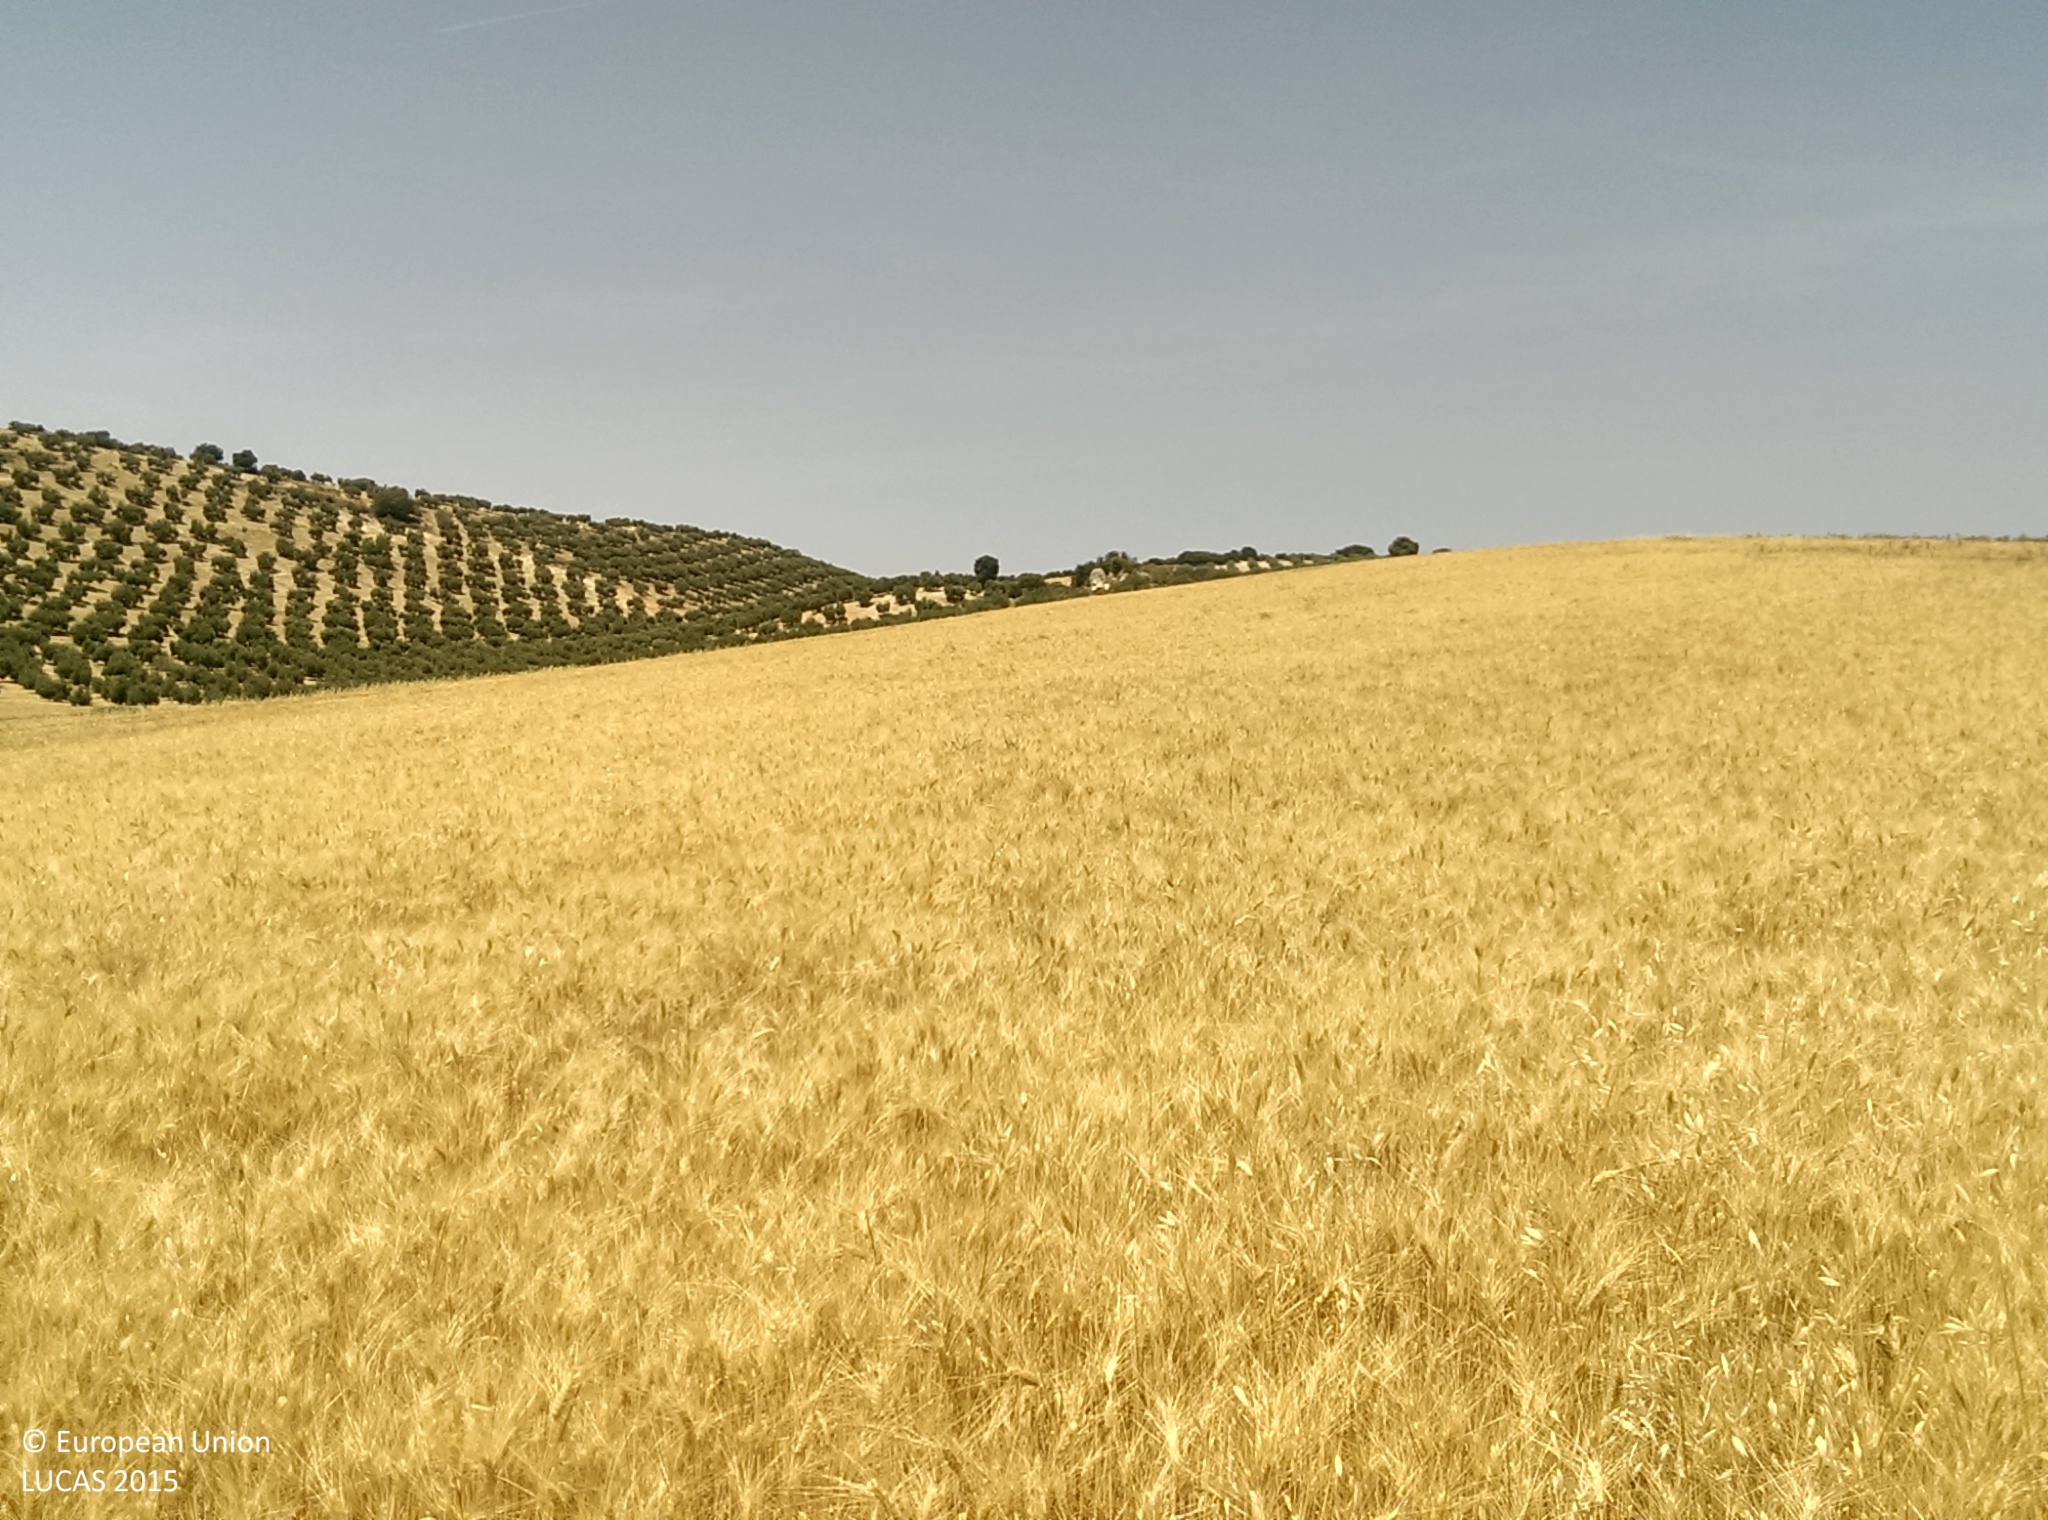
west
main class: Cropland
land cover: Common wheat
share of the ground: > 75 %
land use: Agriculture (excluding fallow land and kitchen gardens)
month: July
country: ES
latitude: 37.4235
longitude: -3.7468
